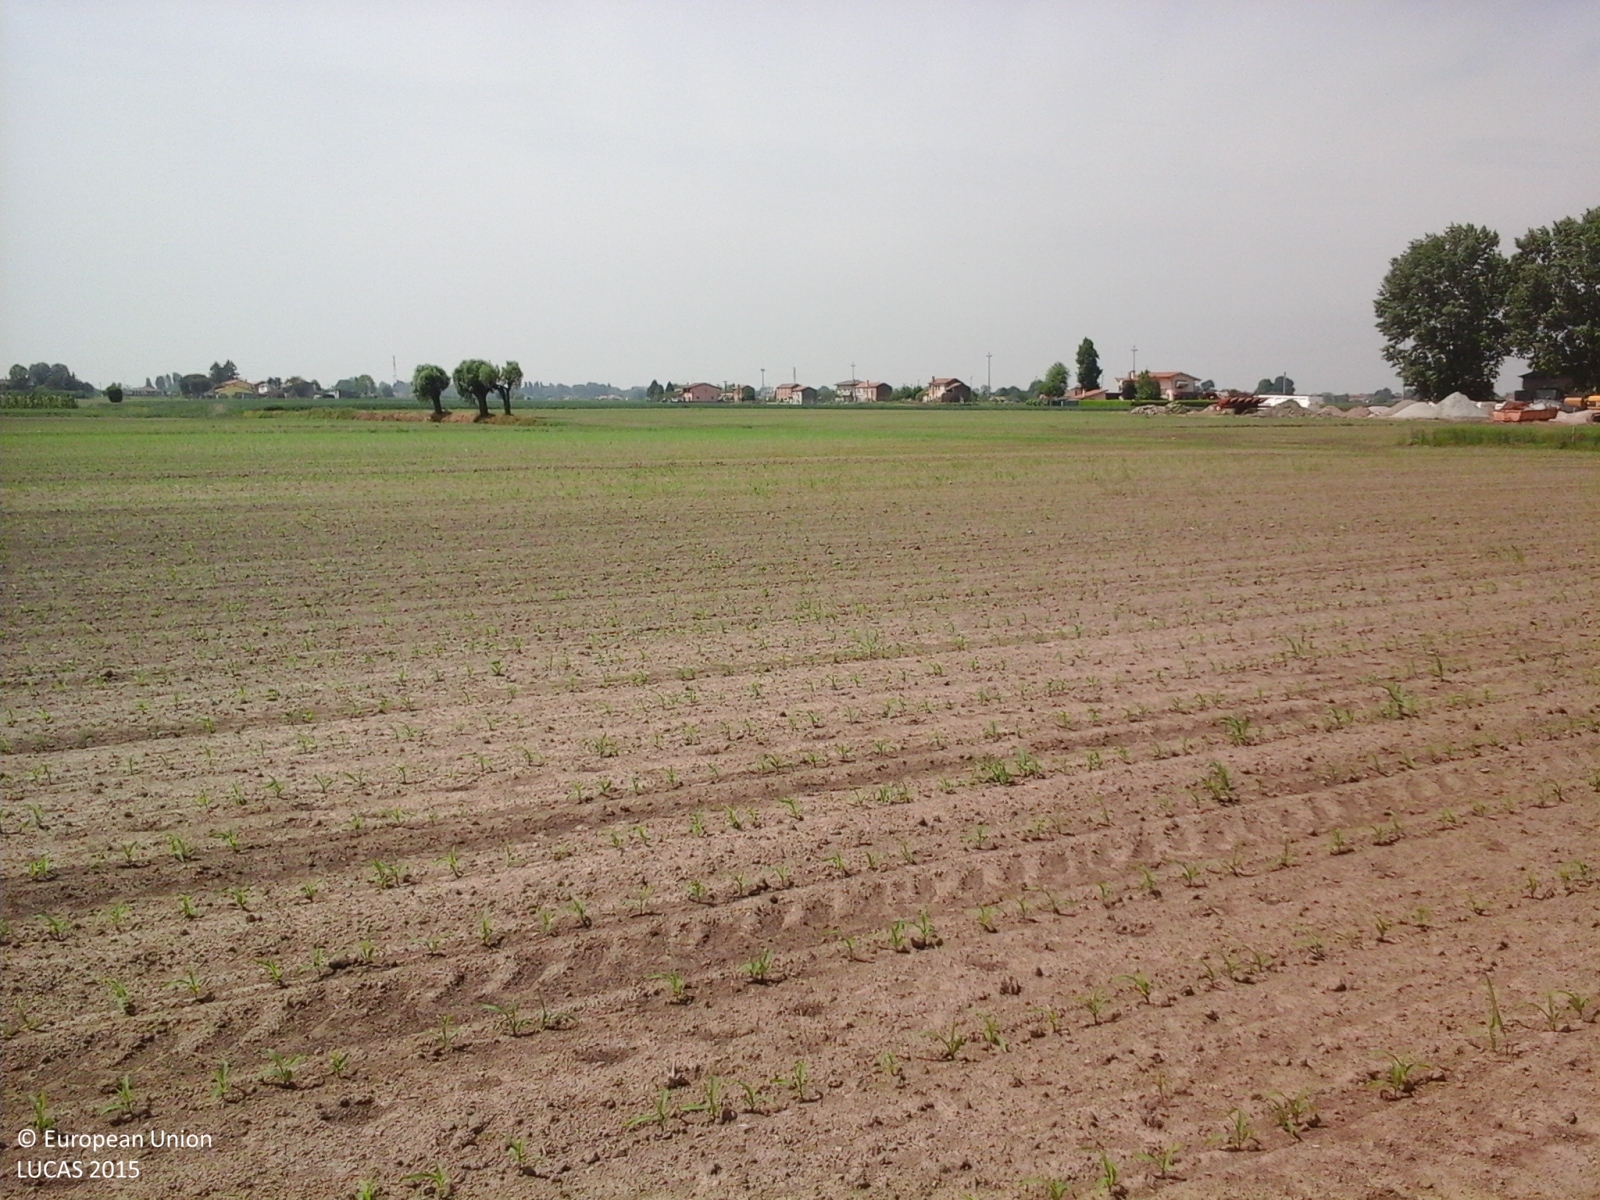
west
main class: Cropland
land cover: Maize
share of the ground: < 10 %
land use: Agriculture (excluding fallow land and kitchen gardens)
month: May
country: IT
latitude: 45.1287
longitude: 11.7895
